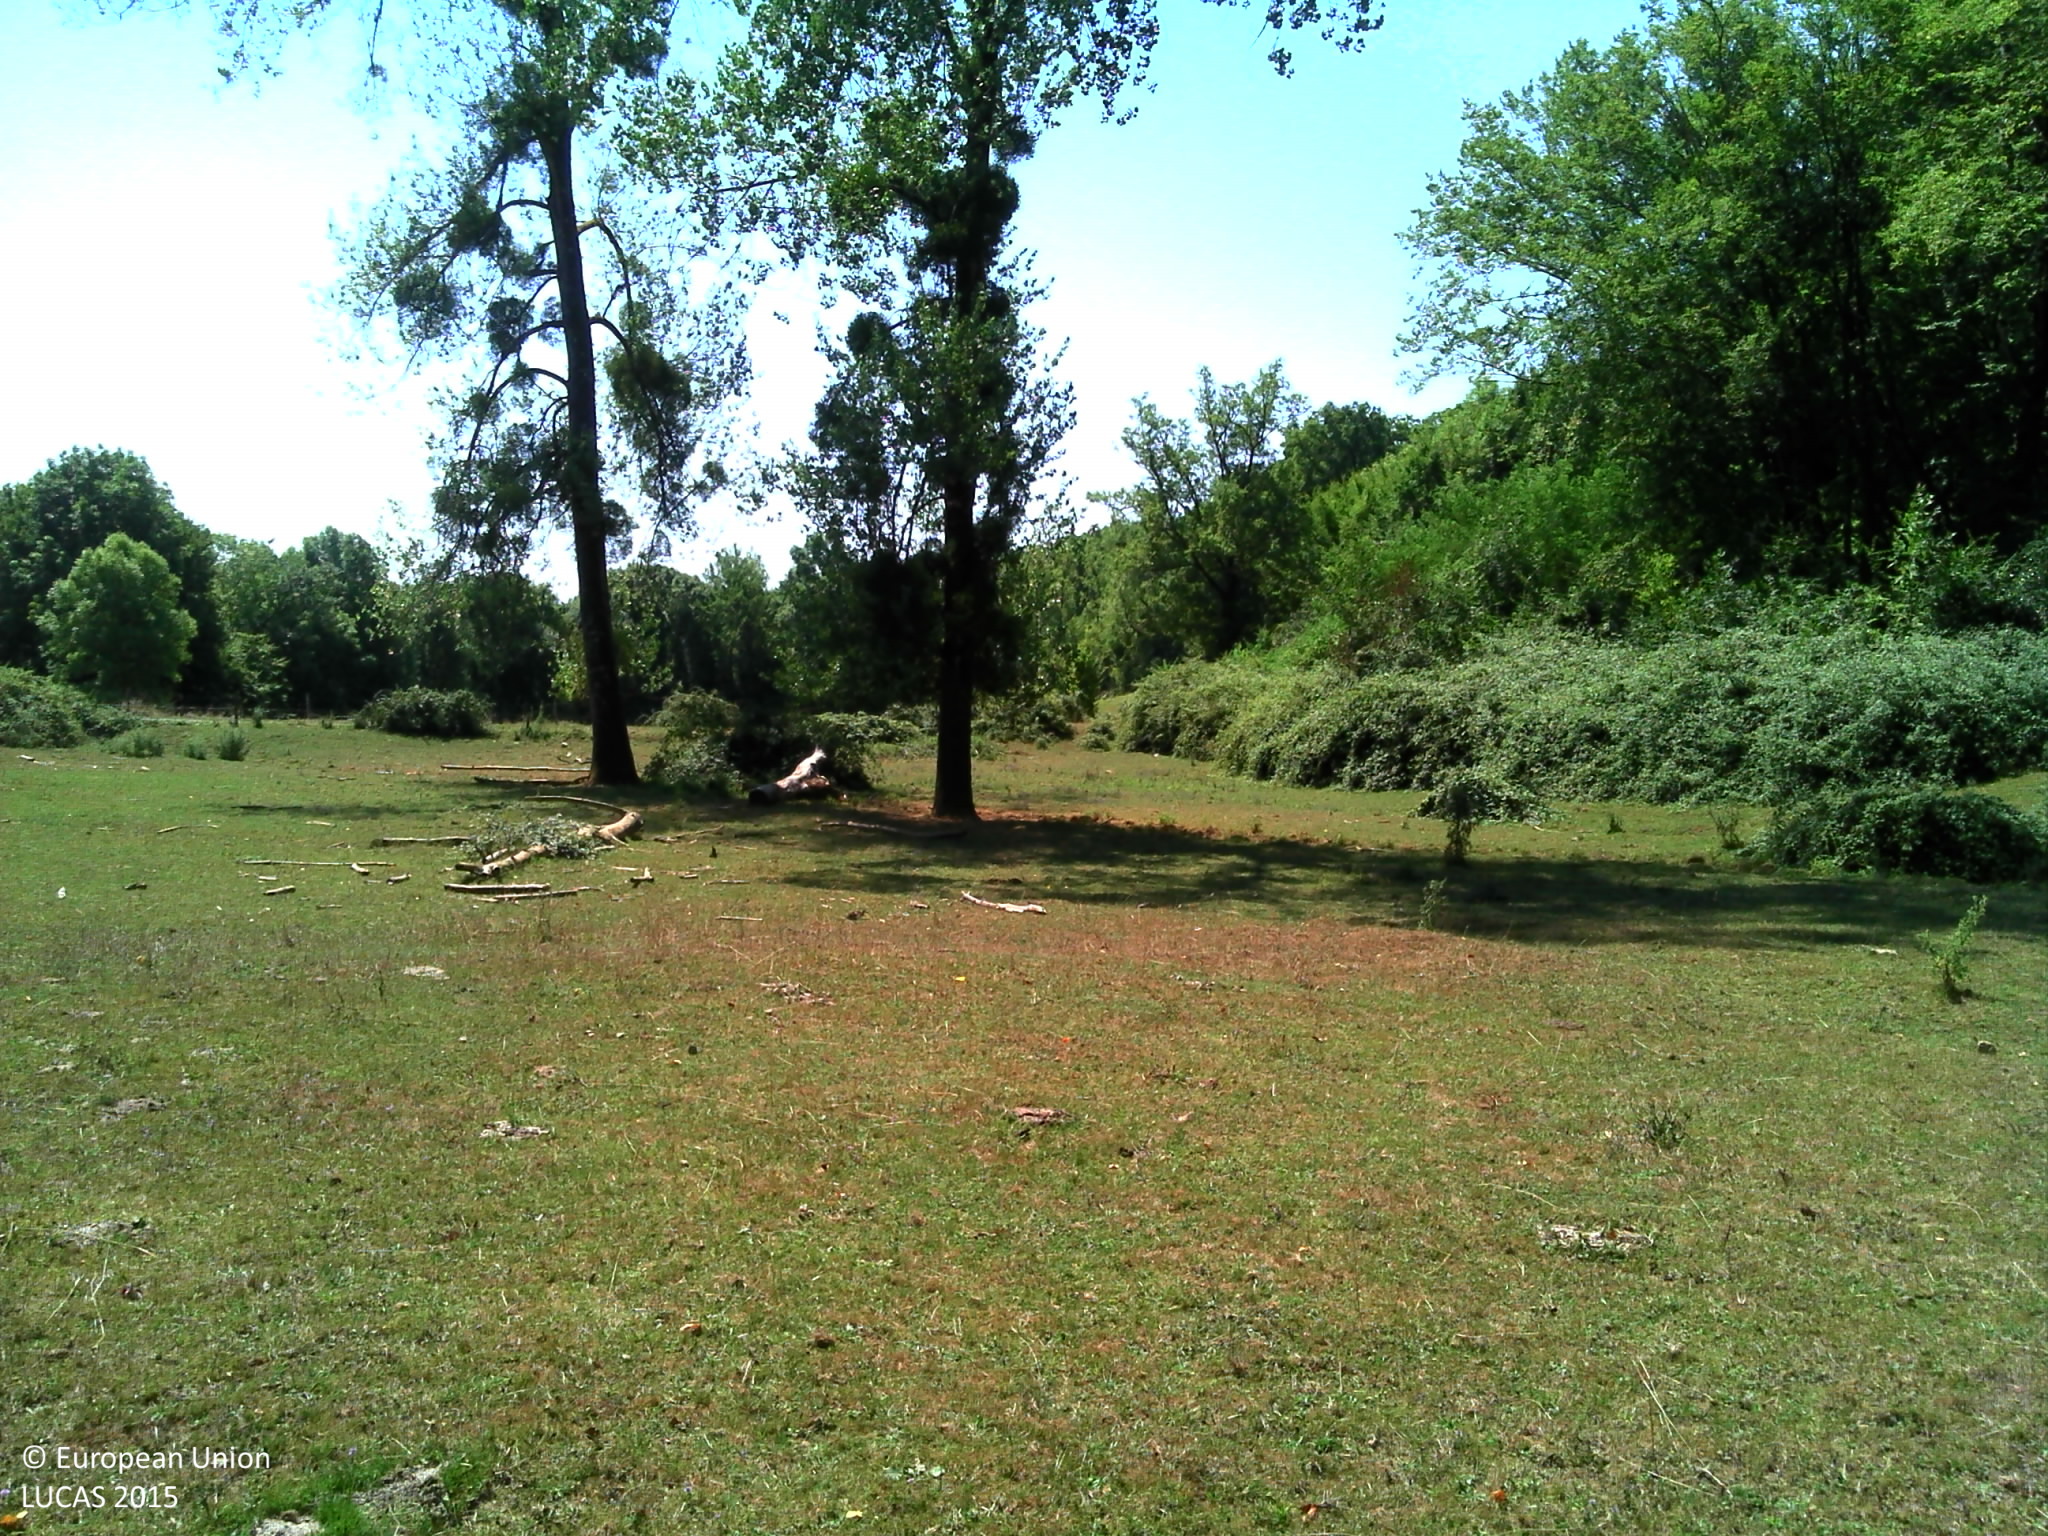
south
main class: Grassland
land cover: Grassland without tree/shrub cover
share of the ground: > 75 %
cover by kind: herbaceous plants 100 %
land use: Agriculture (excluding fallow land and kitchen gardens)
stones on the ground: < 10 %
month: August
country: FR
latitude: 45.3586
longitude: 1.0427
